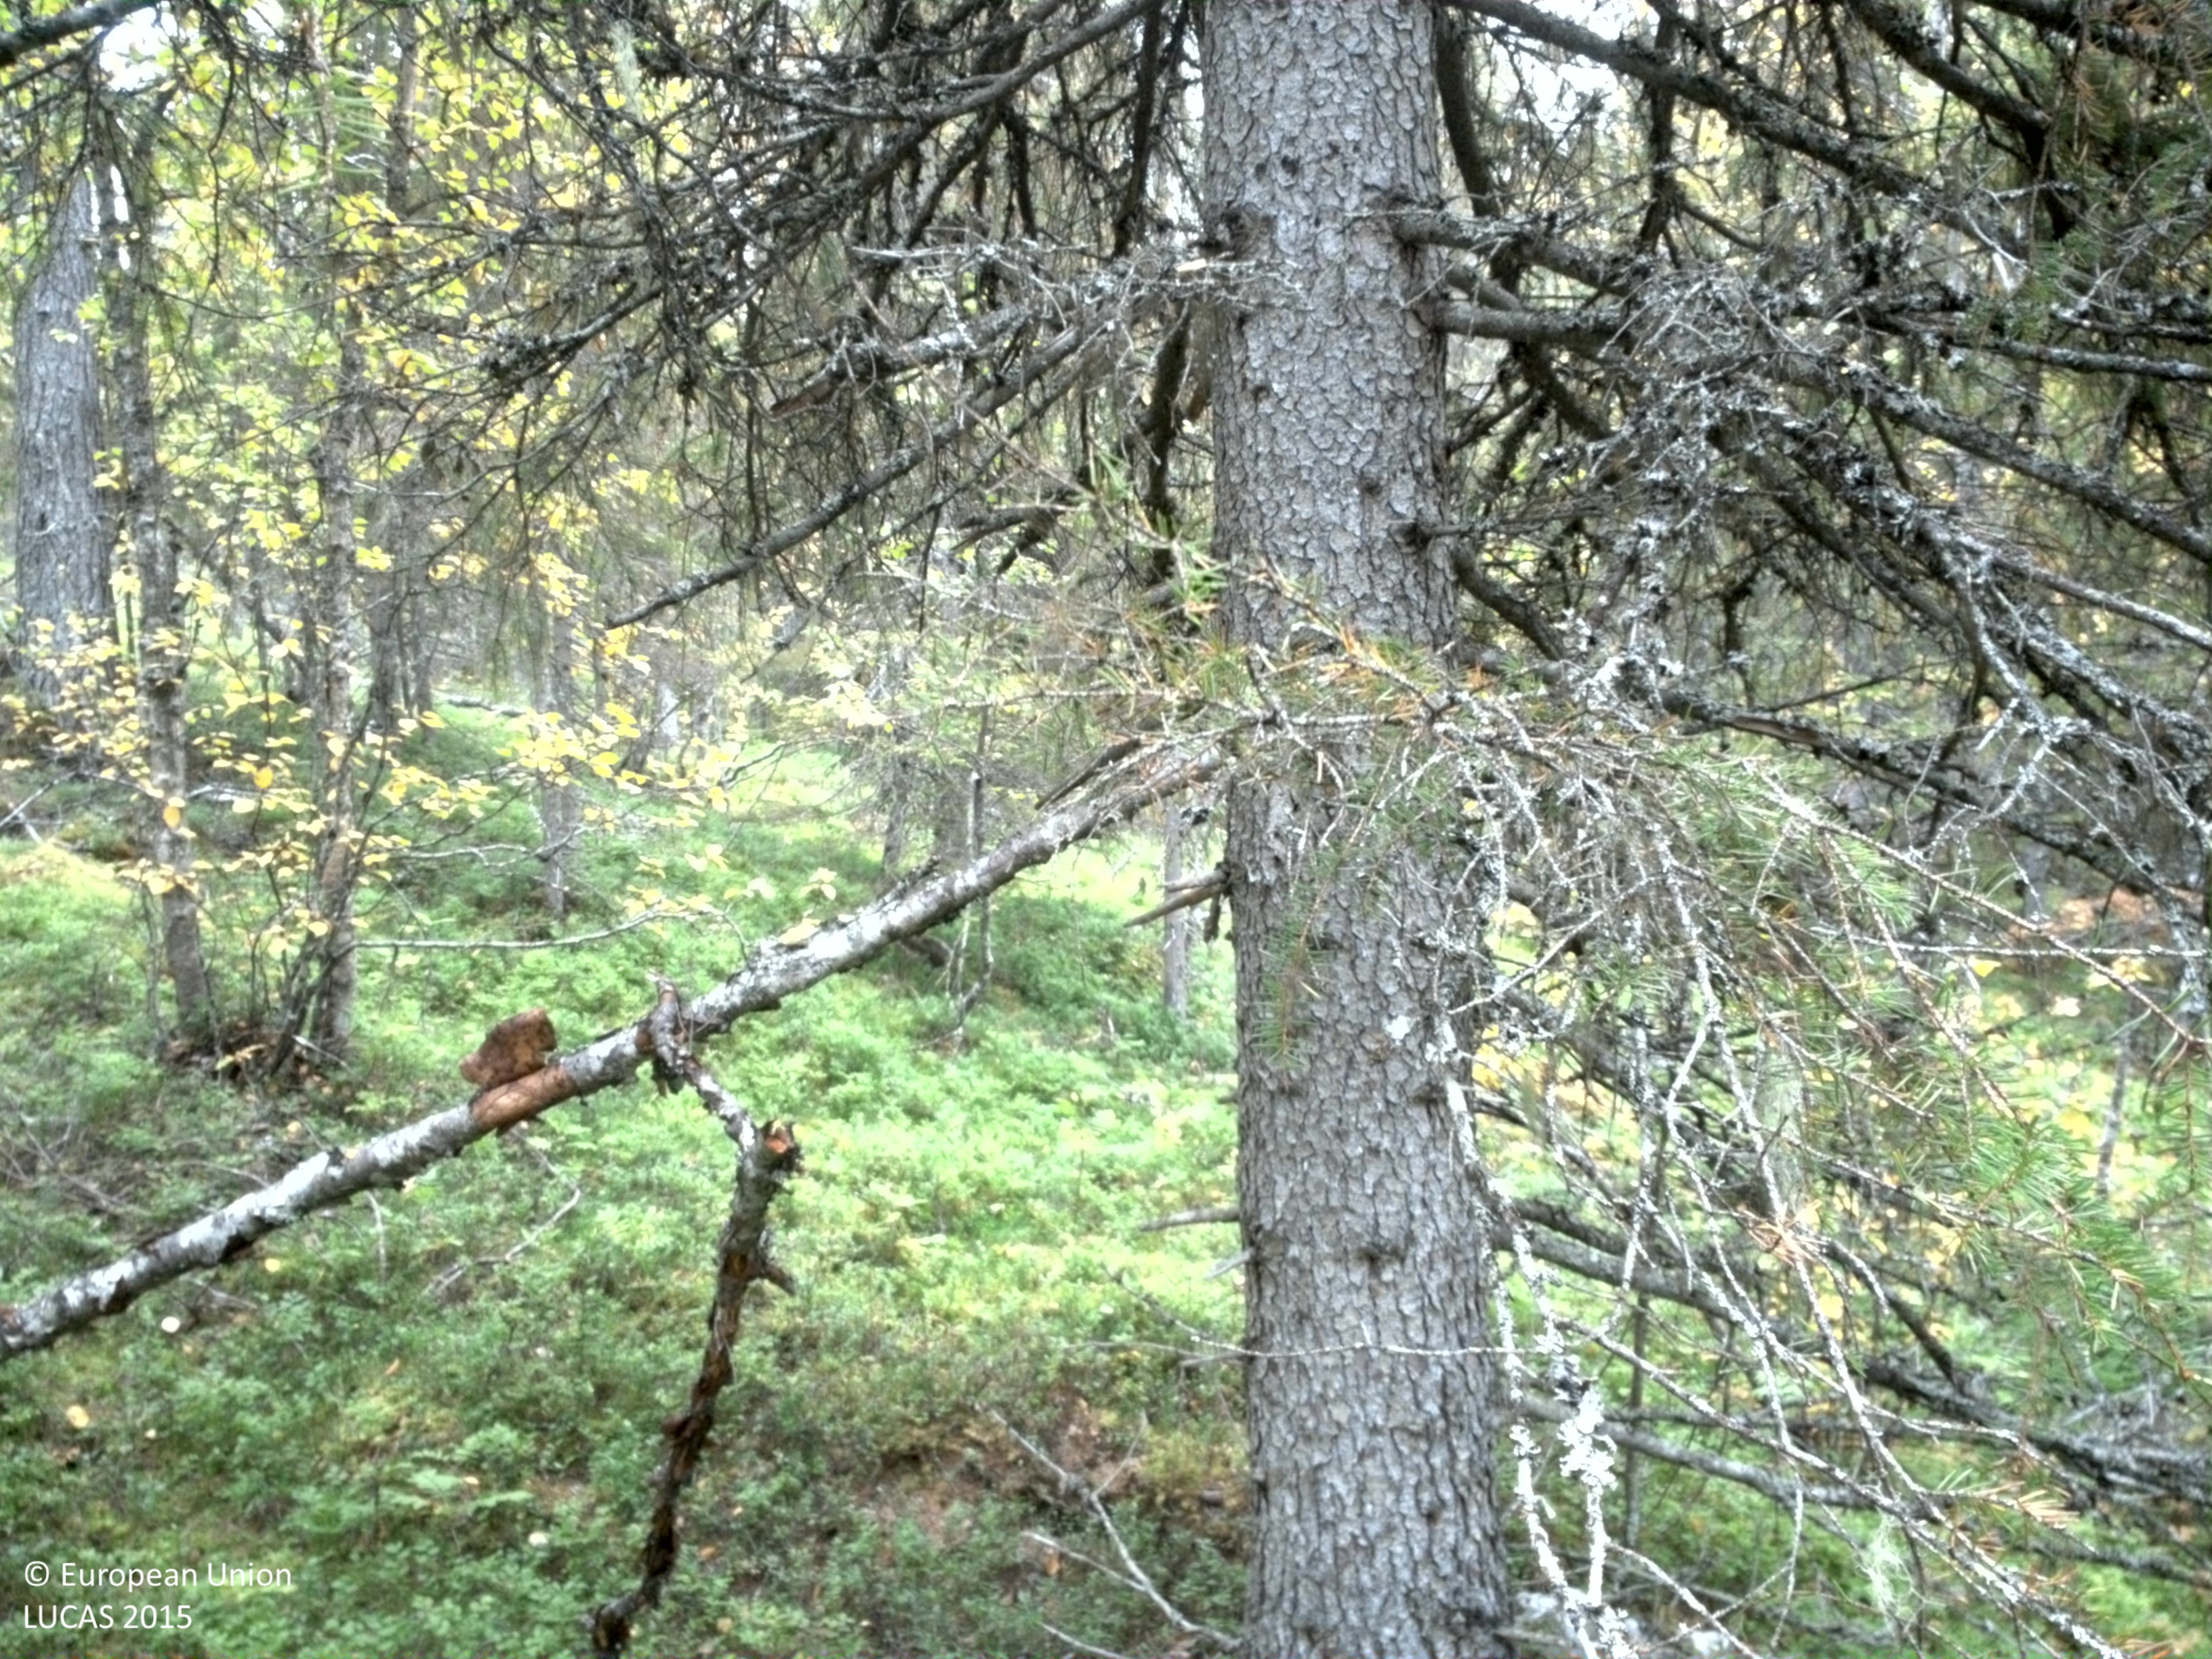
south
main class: Woodland
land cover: Spruce dominated mixed woodland
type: boreal forest
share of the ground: 25 - 50 %
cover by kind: shrubs 40 %, coniferous forest trees 25 %, lichens and mosses 15 %, broadleaved forest trees 10 %, herbaceous plants 10 %
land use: Forestry
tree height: > 5 m
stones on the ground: 10 - 25 %
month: September
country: SE
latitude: 65.1589
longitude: 16.8111
